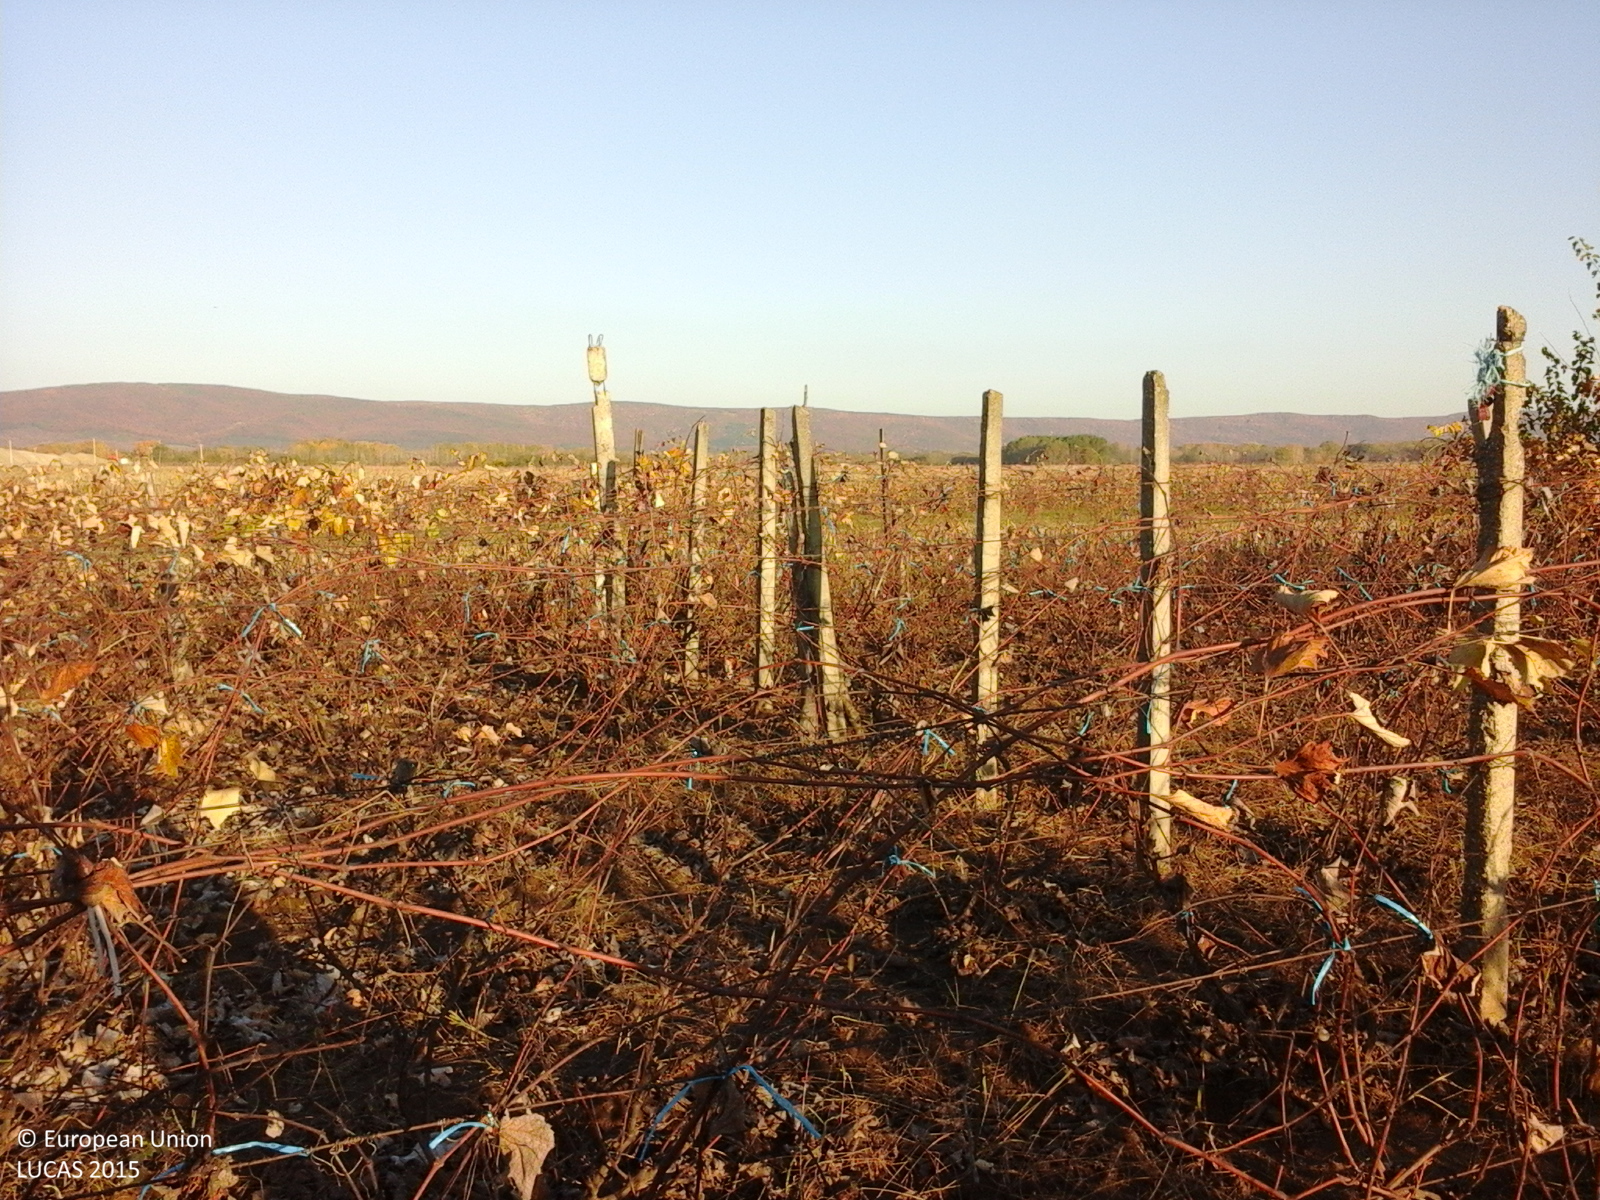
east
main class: Cropland
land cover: Vineyards
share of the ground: 50 - 75 %
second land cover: Other bare soil
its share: > 75 %
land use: Agriculture (excluding fallow land and kitchen gardens)
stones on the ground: < 10 %
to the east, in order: Vineyards; Other bare soil; Fences; Maize; Lucerne; Maize; Other bare soil; Maize; Spontaneously vegetated surfaces; Maize
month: October
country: RO
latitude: 46.1230
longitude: 27.1938
